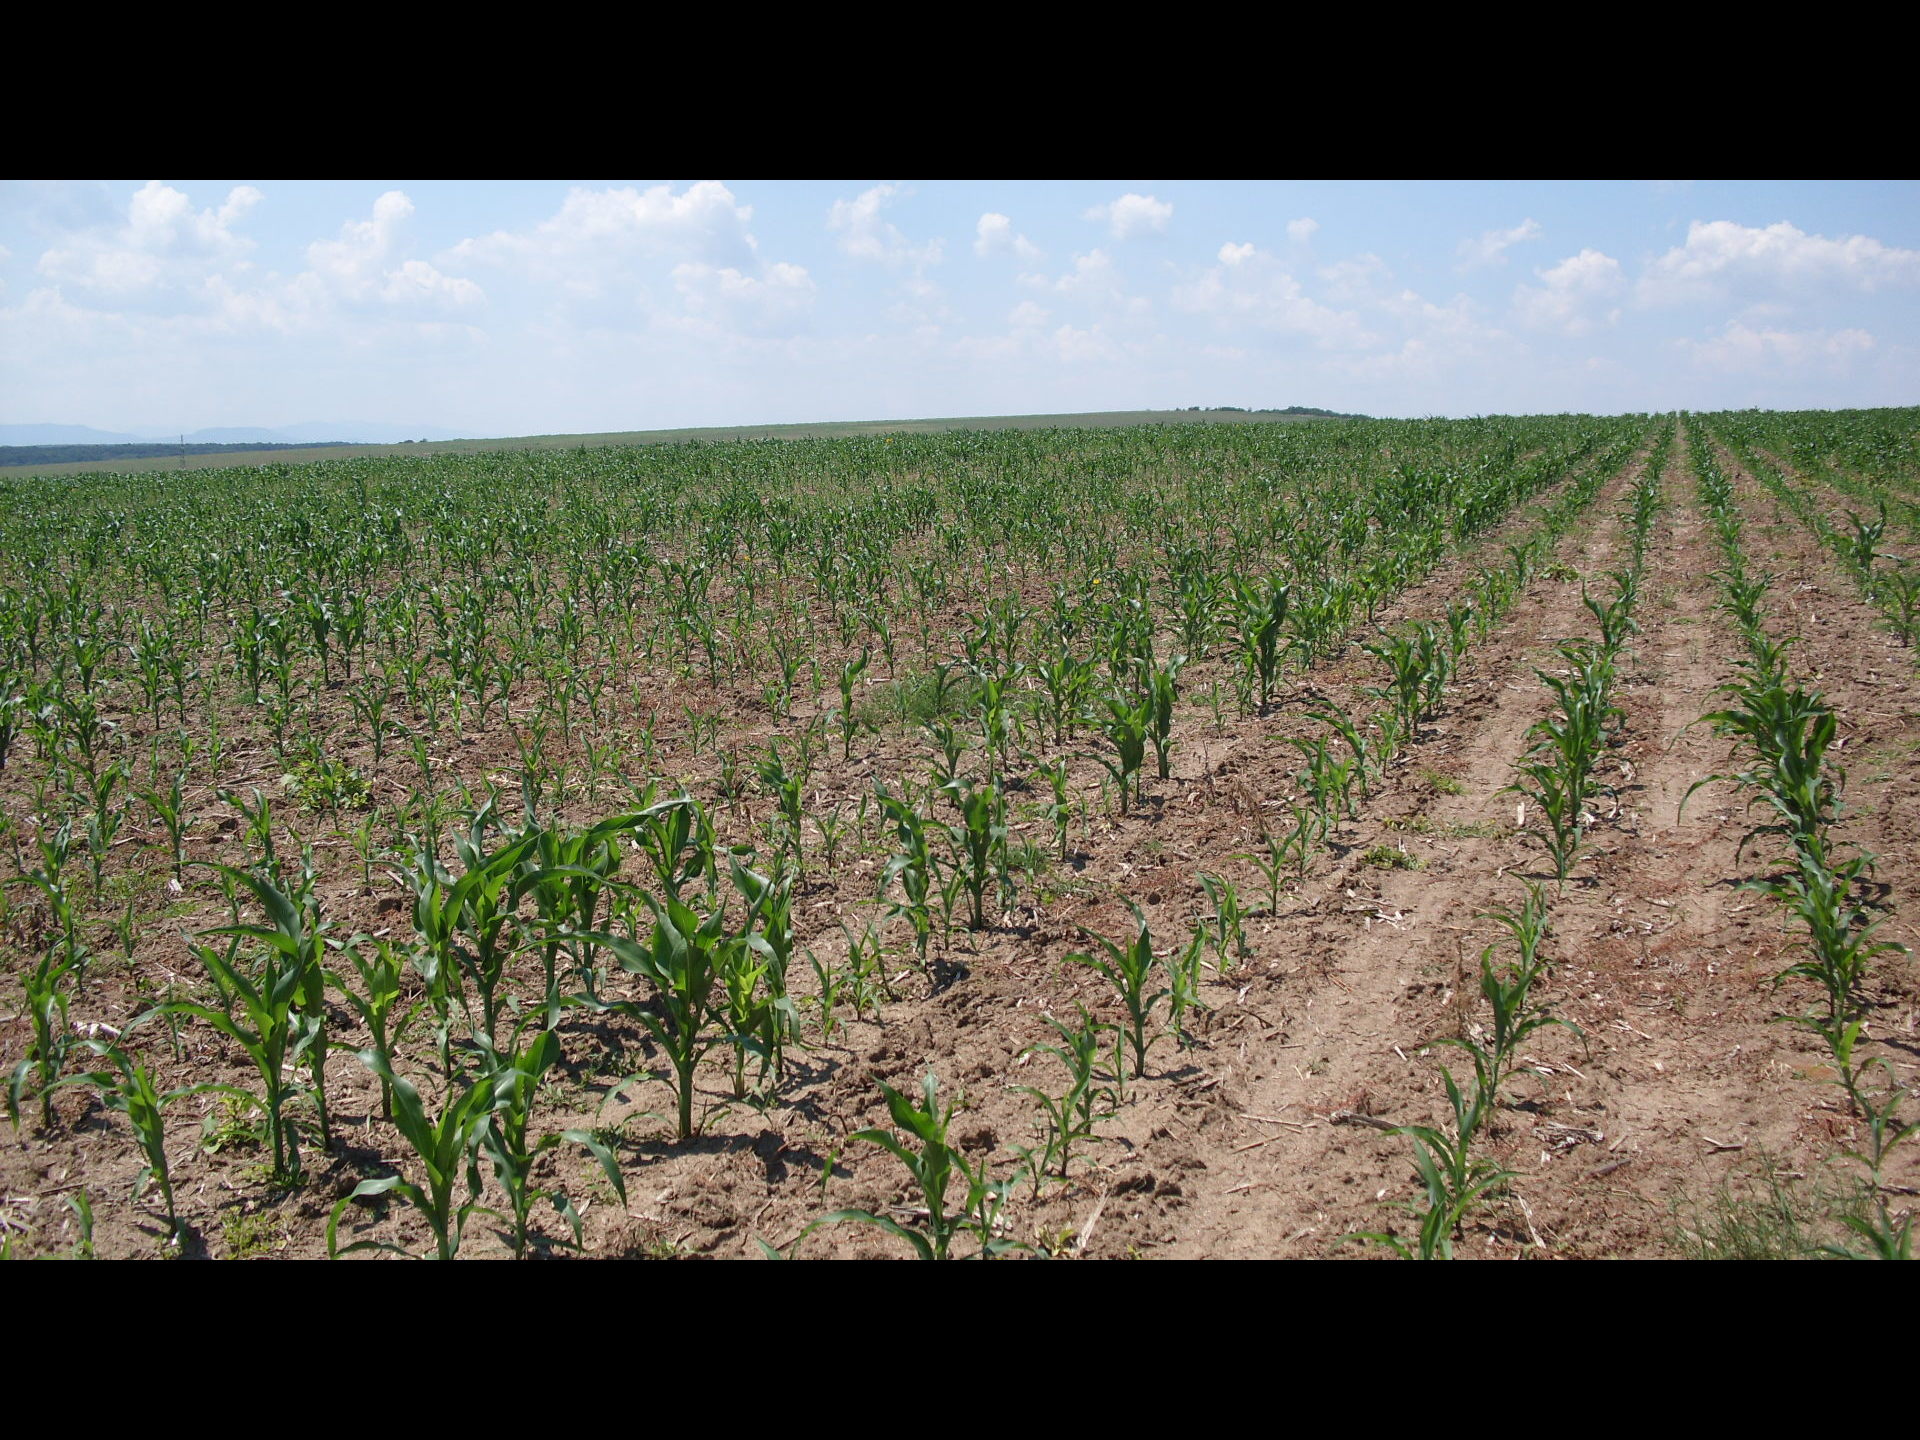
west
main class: Cropland
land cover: Maize
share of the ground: 25 - 50 %
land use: Agriculture (excluding fallow land and kitchen gardens)
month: July
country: BG
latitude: 43.7760
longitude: 22.9224
